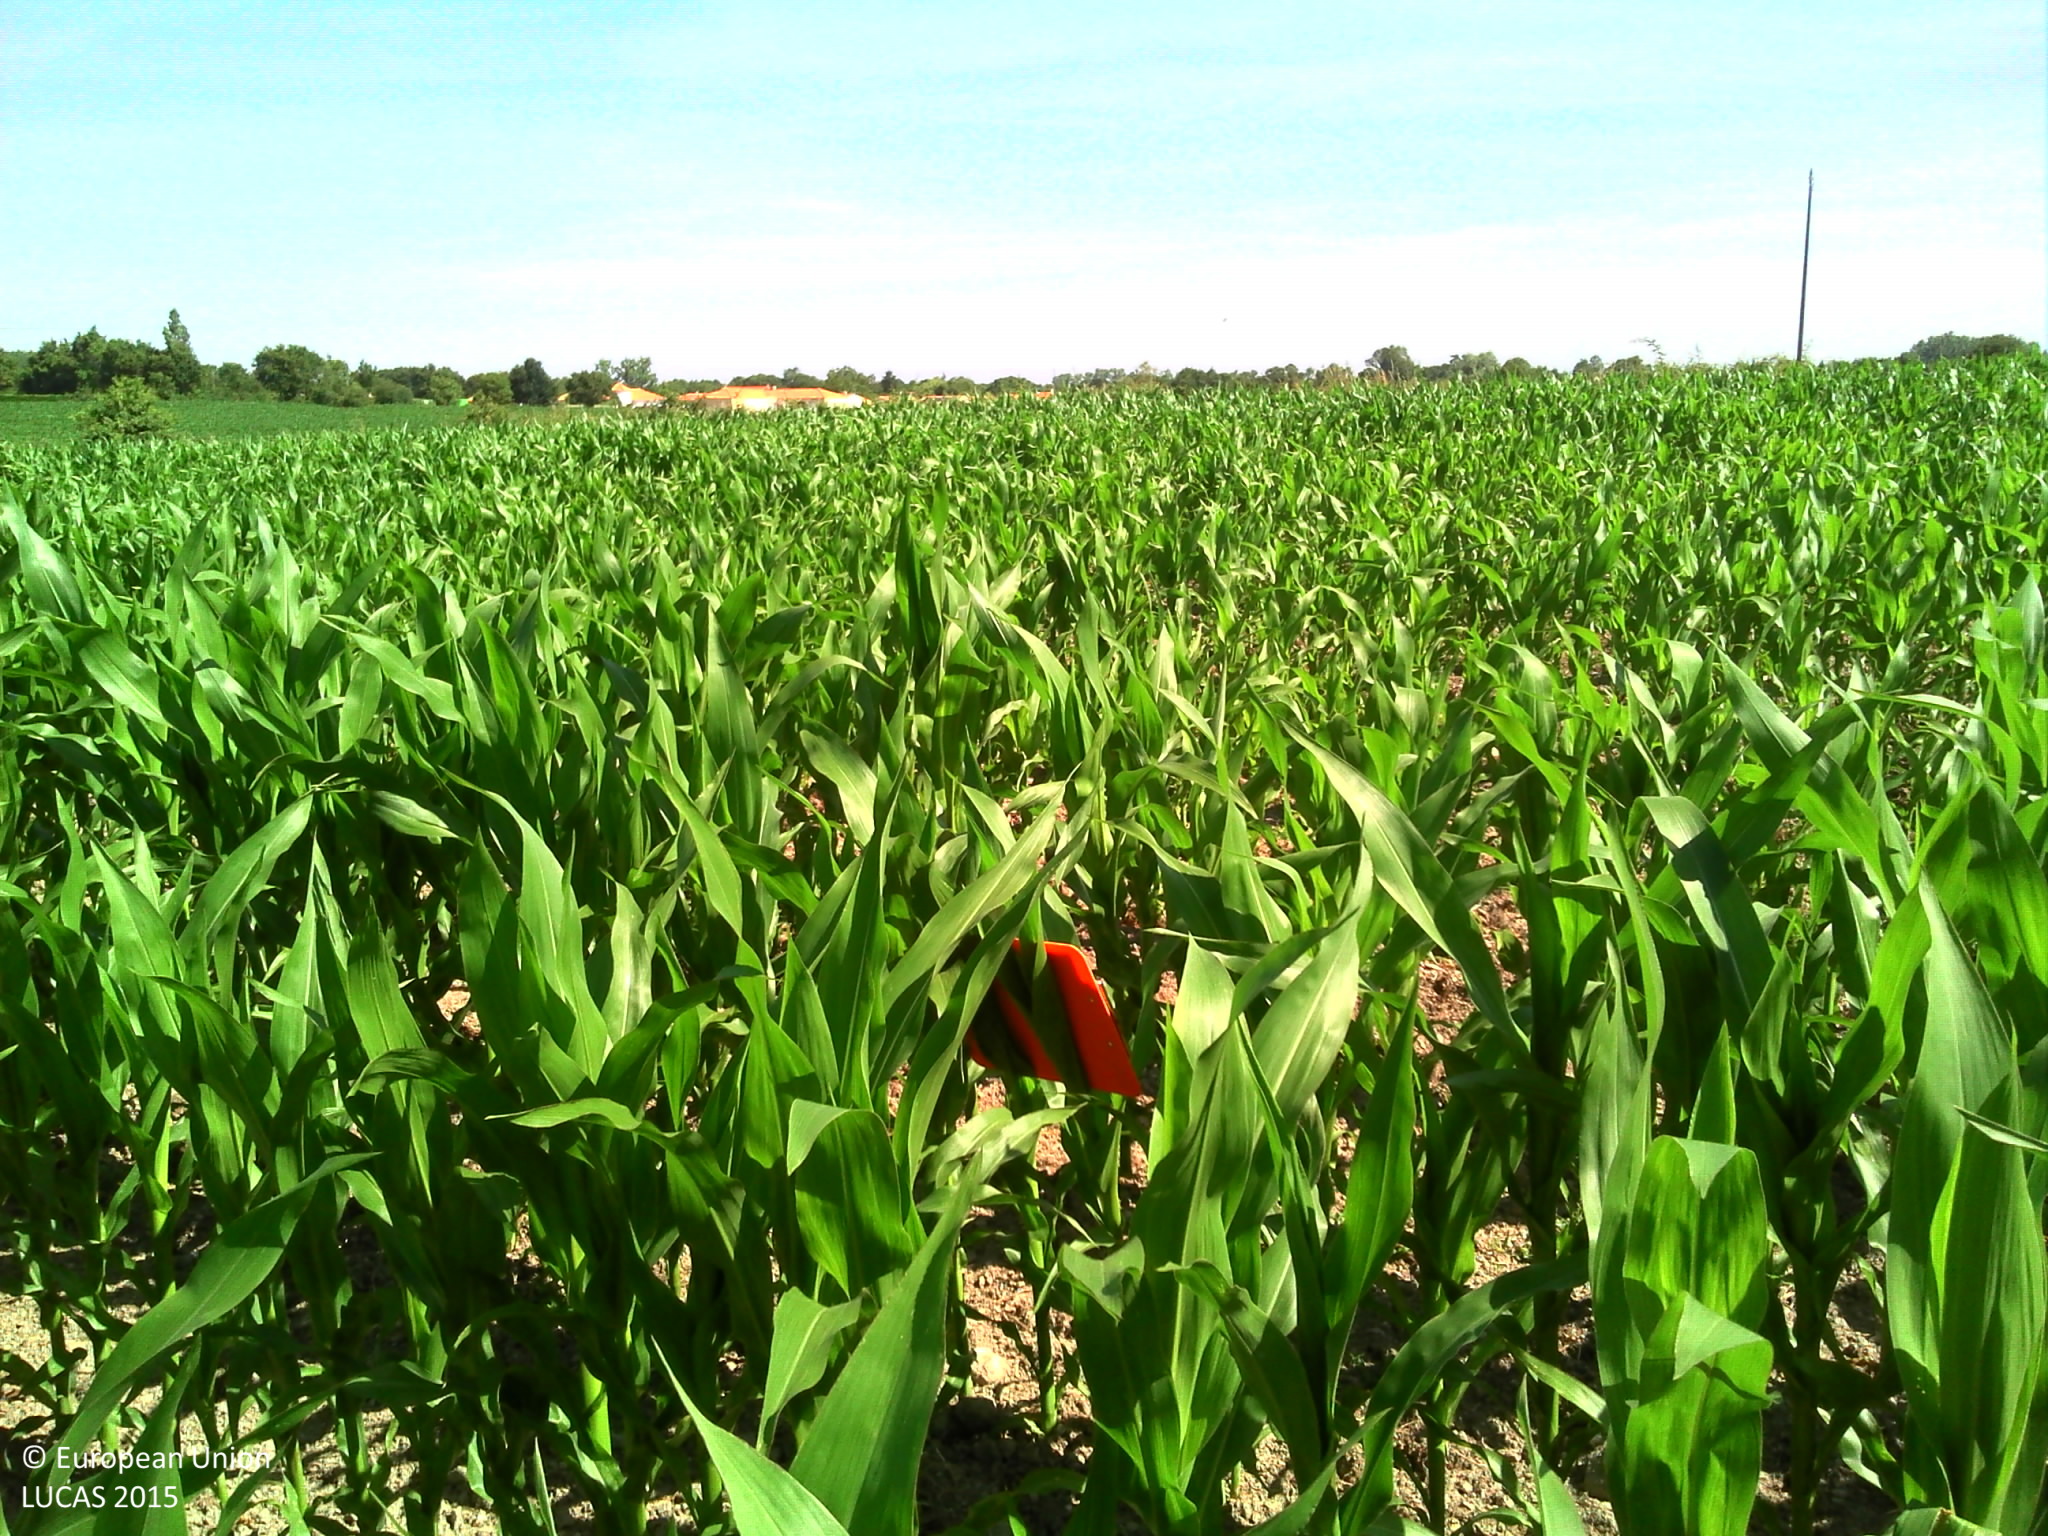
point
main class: Cropland
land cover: Maize
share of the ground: > 75 %
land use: Agriculture (excluding fallow land and kitchen gardens)
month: June
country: FR
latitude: 46.9412
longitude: -1.7215
